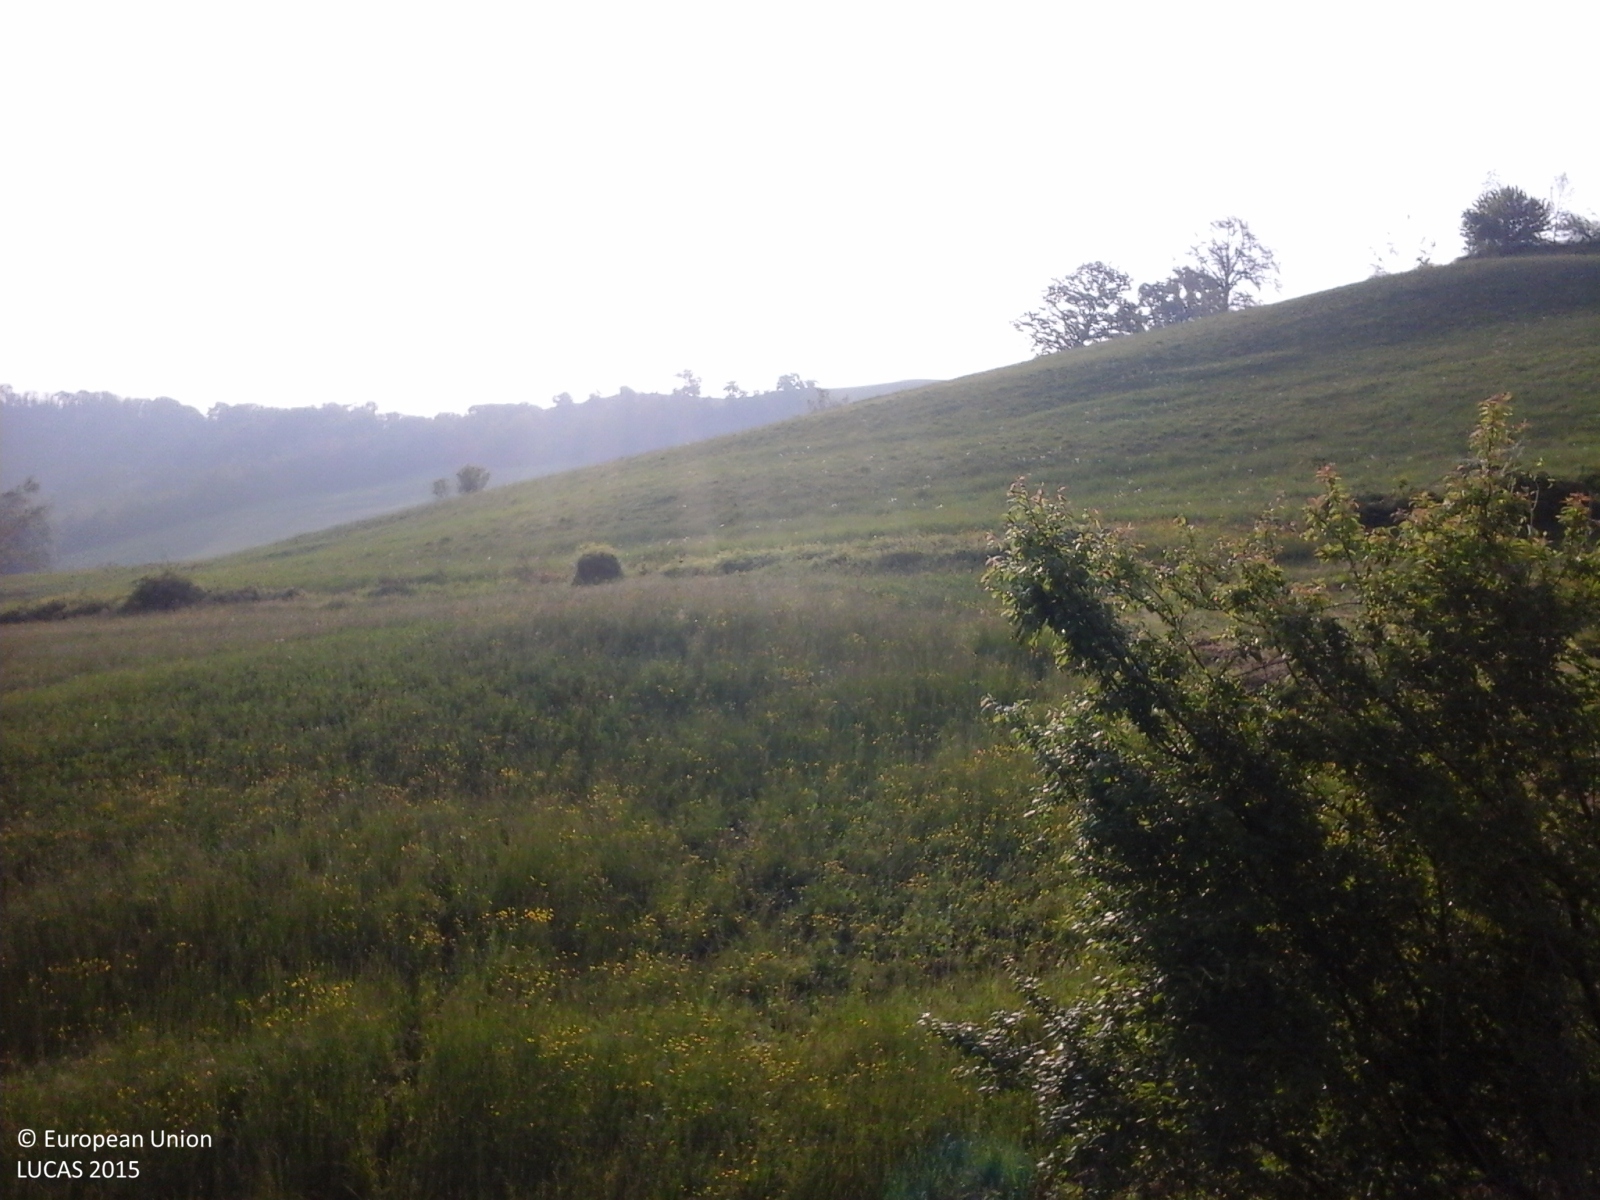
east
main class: Woodland
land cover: Broadleaved woodland
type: mesophytic deciduous forest
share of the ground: > 75 %
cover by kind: broadleaved forest trees 70 %, shrubs 30 %
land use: Semi-natural and natural areas not in use
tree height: > 5 m
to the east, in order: Broadleaved woodland; Grassland without tree/shrub cover; Ditches and canals; Temporary grasslands; Ditches and canals; Abandoned hedges; Temporary grasslands
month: April
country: IT
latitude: 44.5284
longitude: 10.7157
